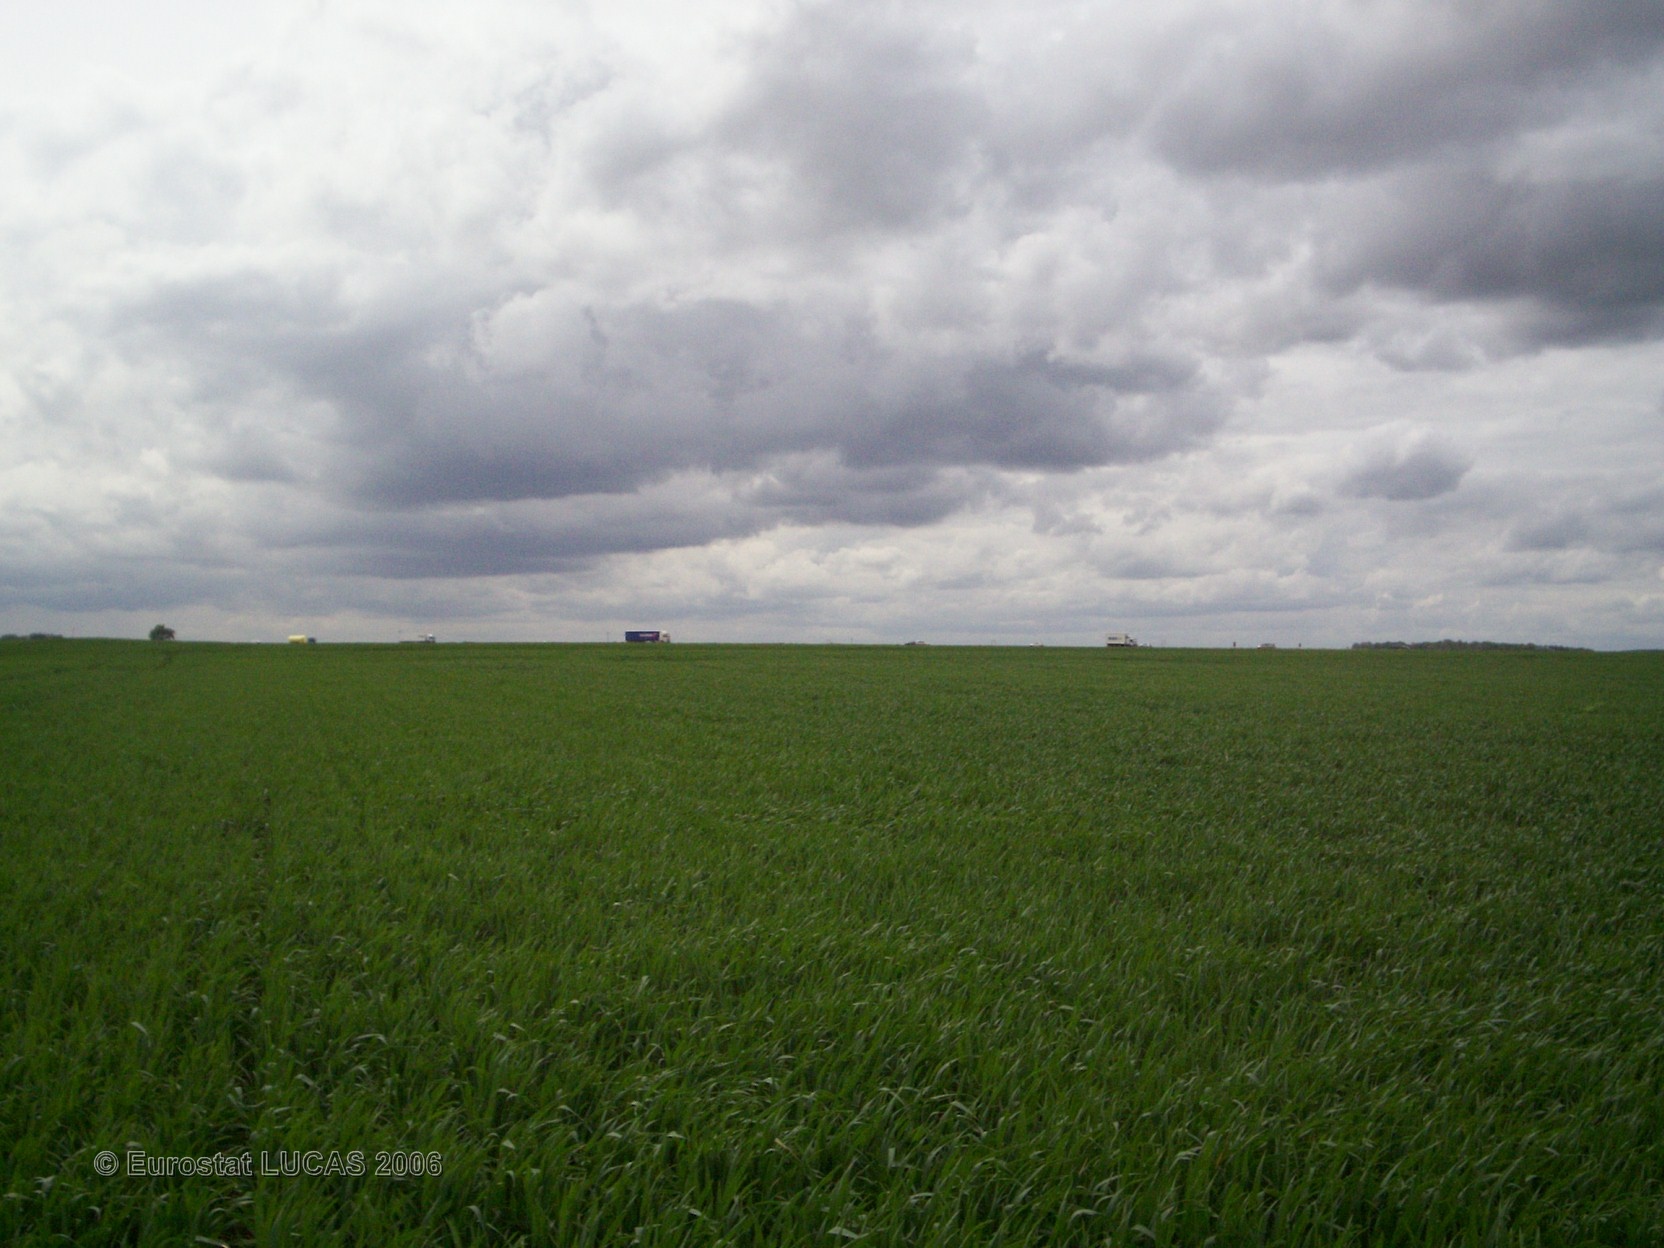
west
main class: Cropland
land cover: Common wheat
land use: Agriculture (excluding fallow land and kitchen gardens)
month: May
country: FR
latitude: 49.1256
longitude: 2.7957
